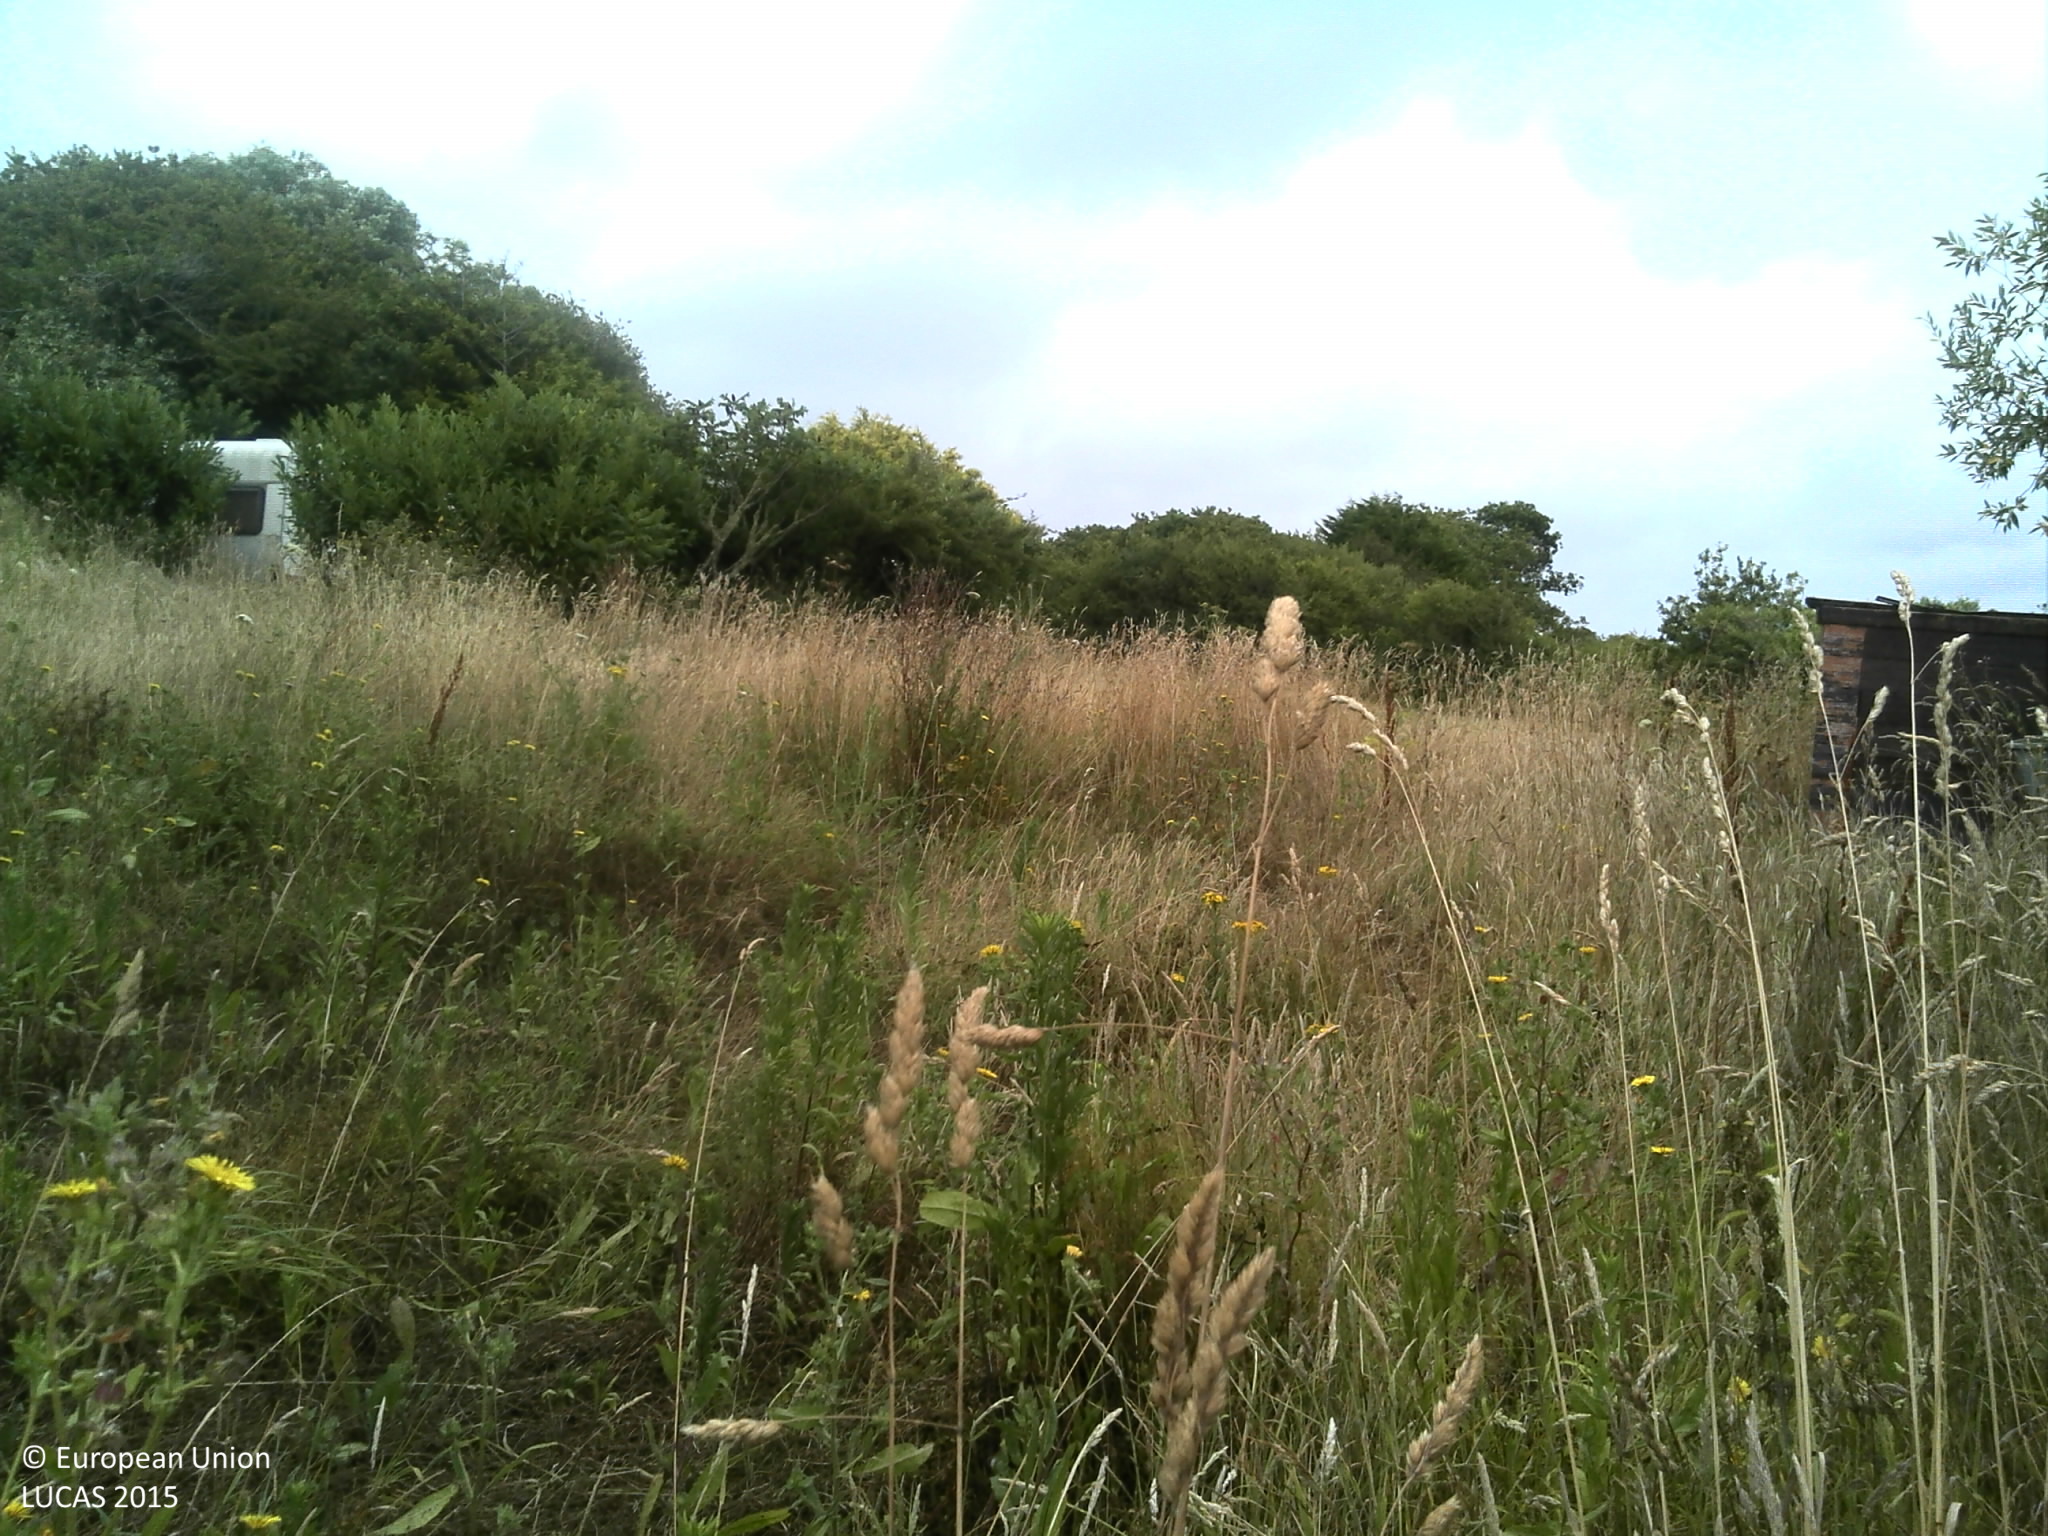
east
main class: Shrubland
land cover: Shrubland without tree cover
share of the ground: > 75 %
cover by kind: shrubs 80 %, herbaceous plants 20 %
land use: Semi-natural and natural areas not in use
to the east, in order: Shrubland without tree cover; Spontaneously vegetated surfaces; Grassland without tree/shrub cover; Spontaneously vegetated surfaces; Managed hedges; Grassland without tree/shrub cover; Broadleaved woodland; Artificial constructions in urban areas
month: July
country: FR
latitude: 48.3449
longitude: -4.4397
